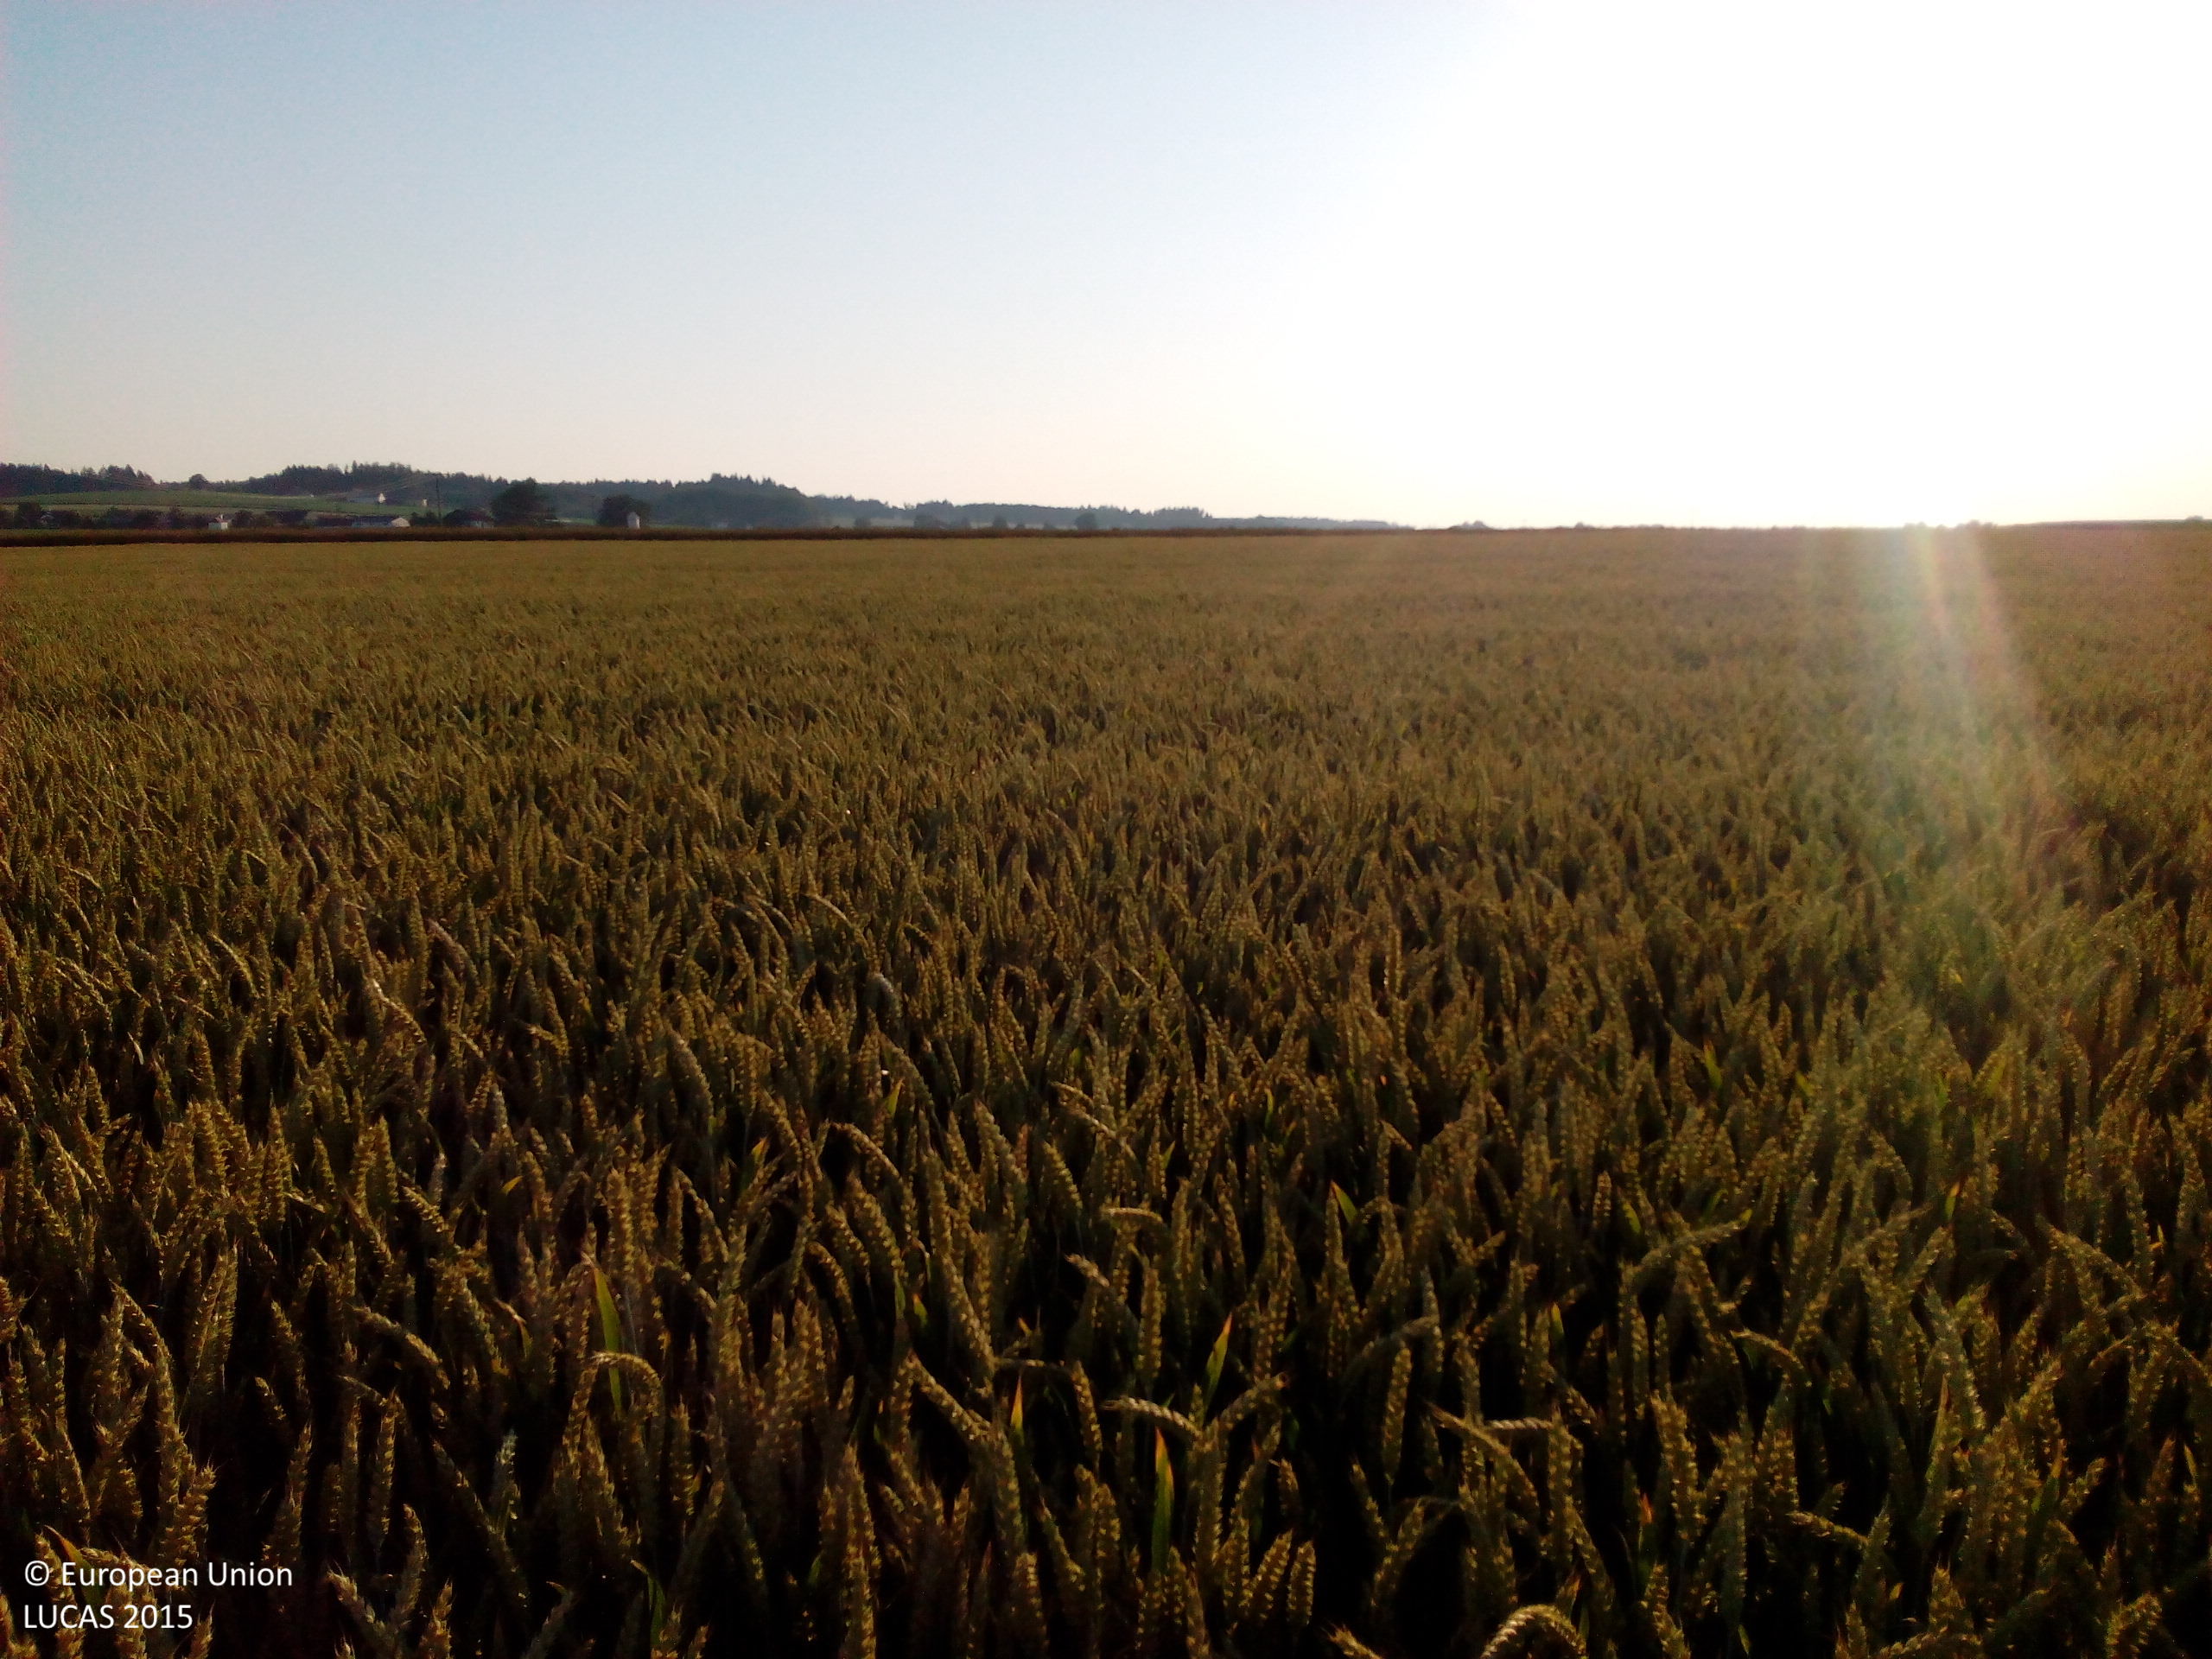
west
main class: Cropland
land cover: Common wheat
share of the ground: > 75 %
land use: Agriculture (excluding fallow land and kitchen gardens)
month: July
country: DE
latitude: 48.6703
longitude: 12.9461
